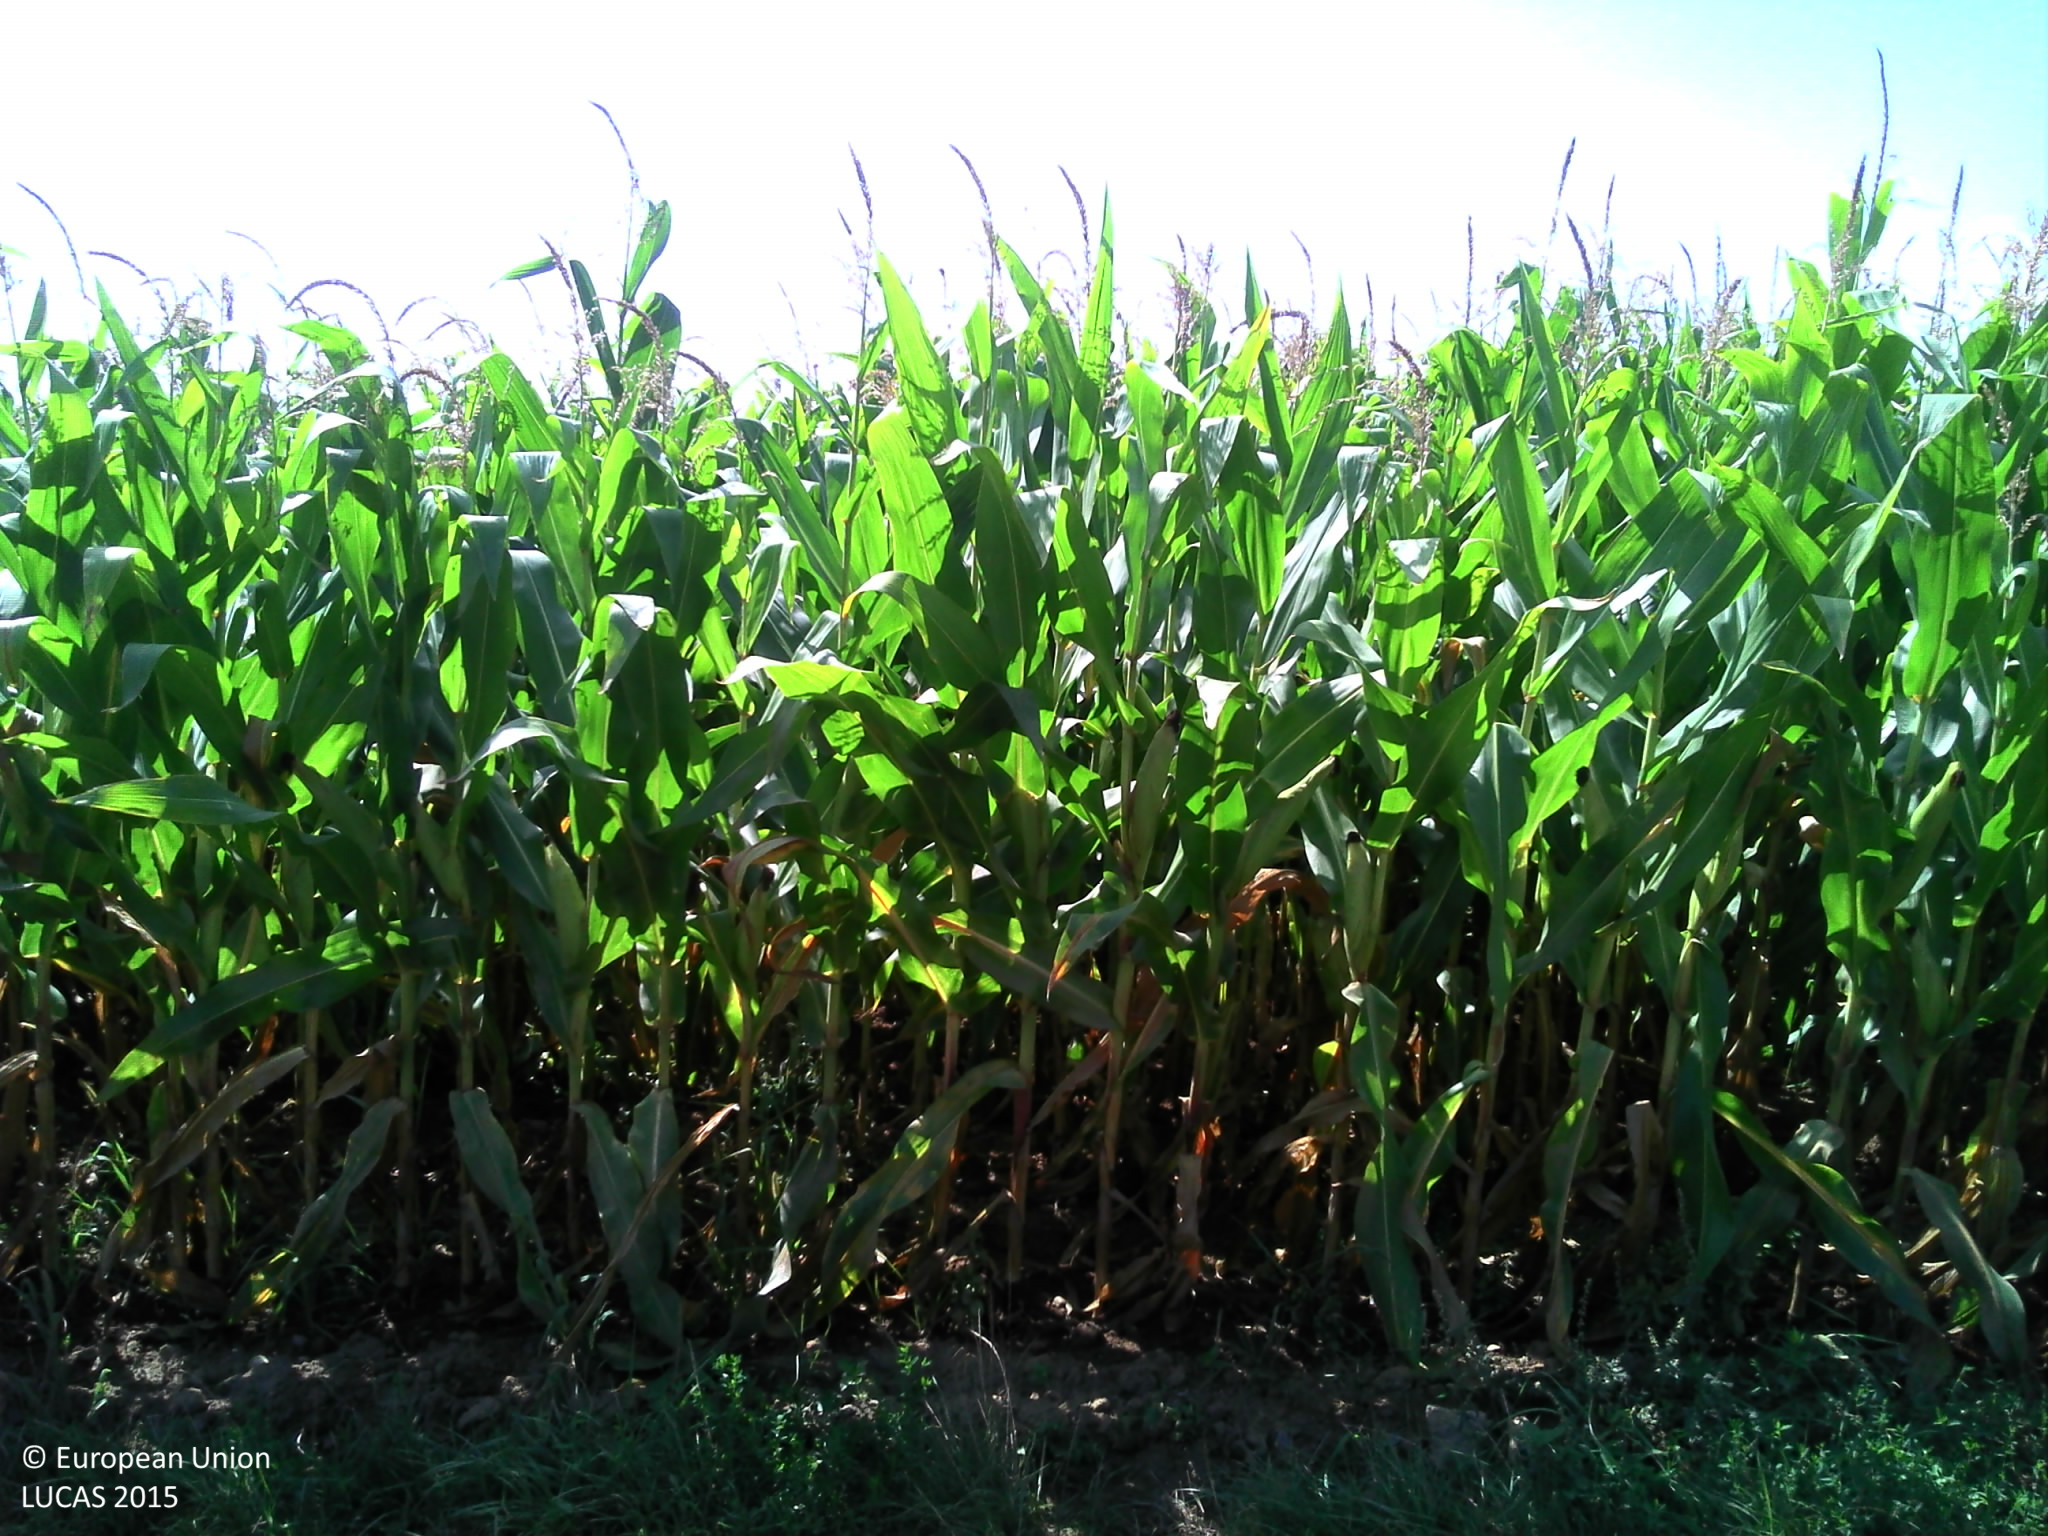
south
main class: Cropland
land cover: Maize
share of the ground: > 75 %
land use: Agriculture (excluding fallow land and kitchen gardens)
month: August
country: FR
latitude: 48.7745
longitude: 7.6466
